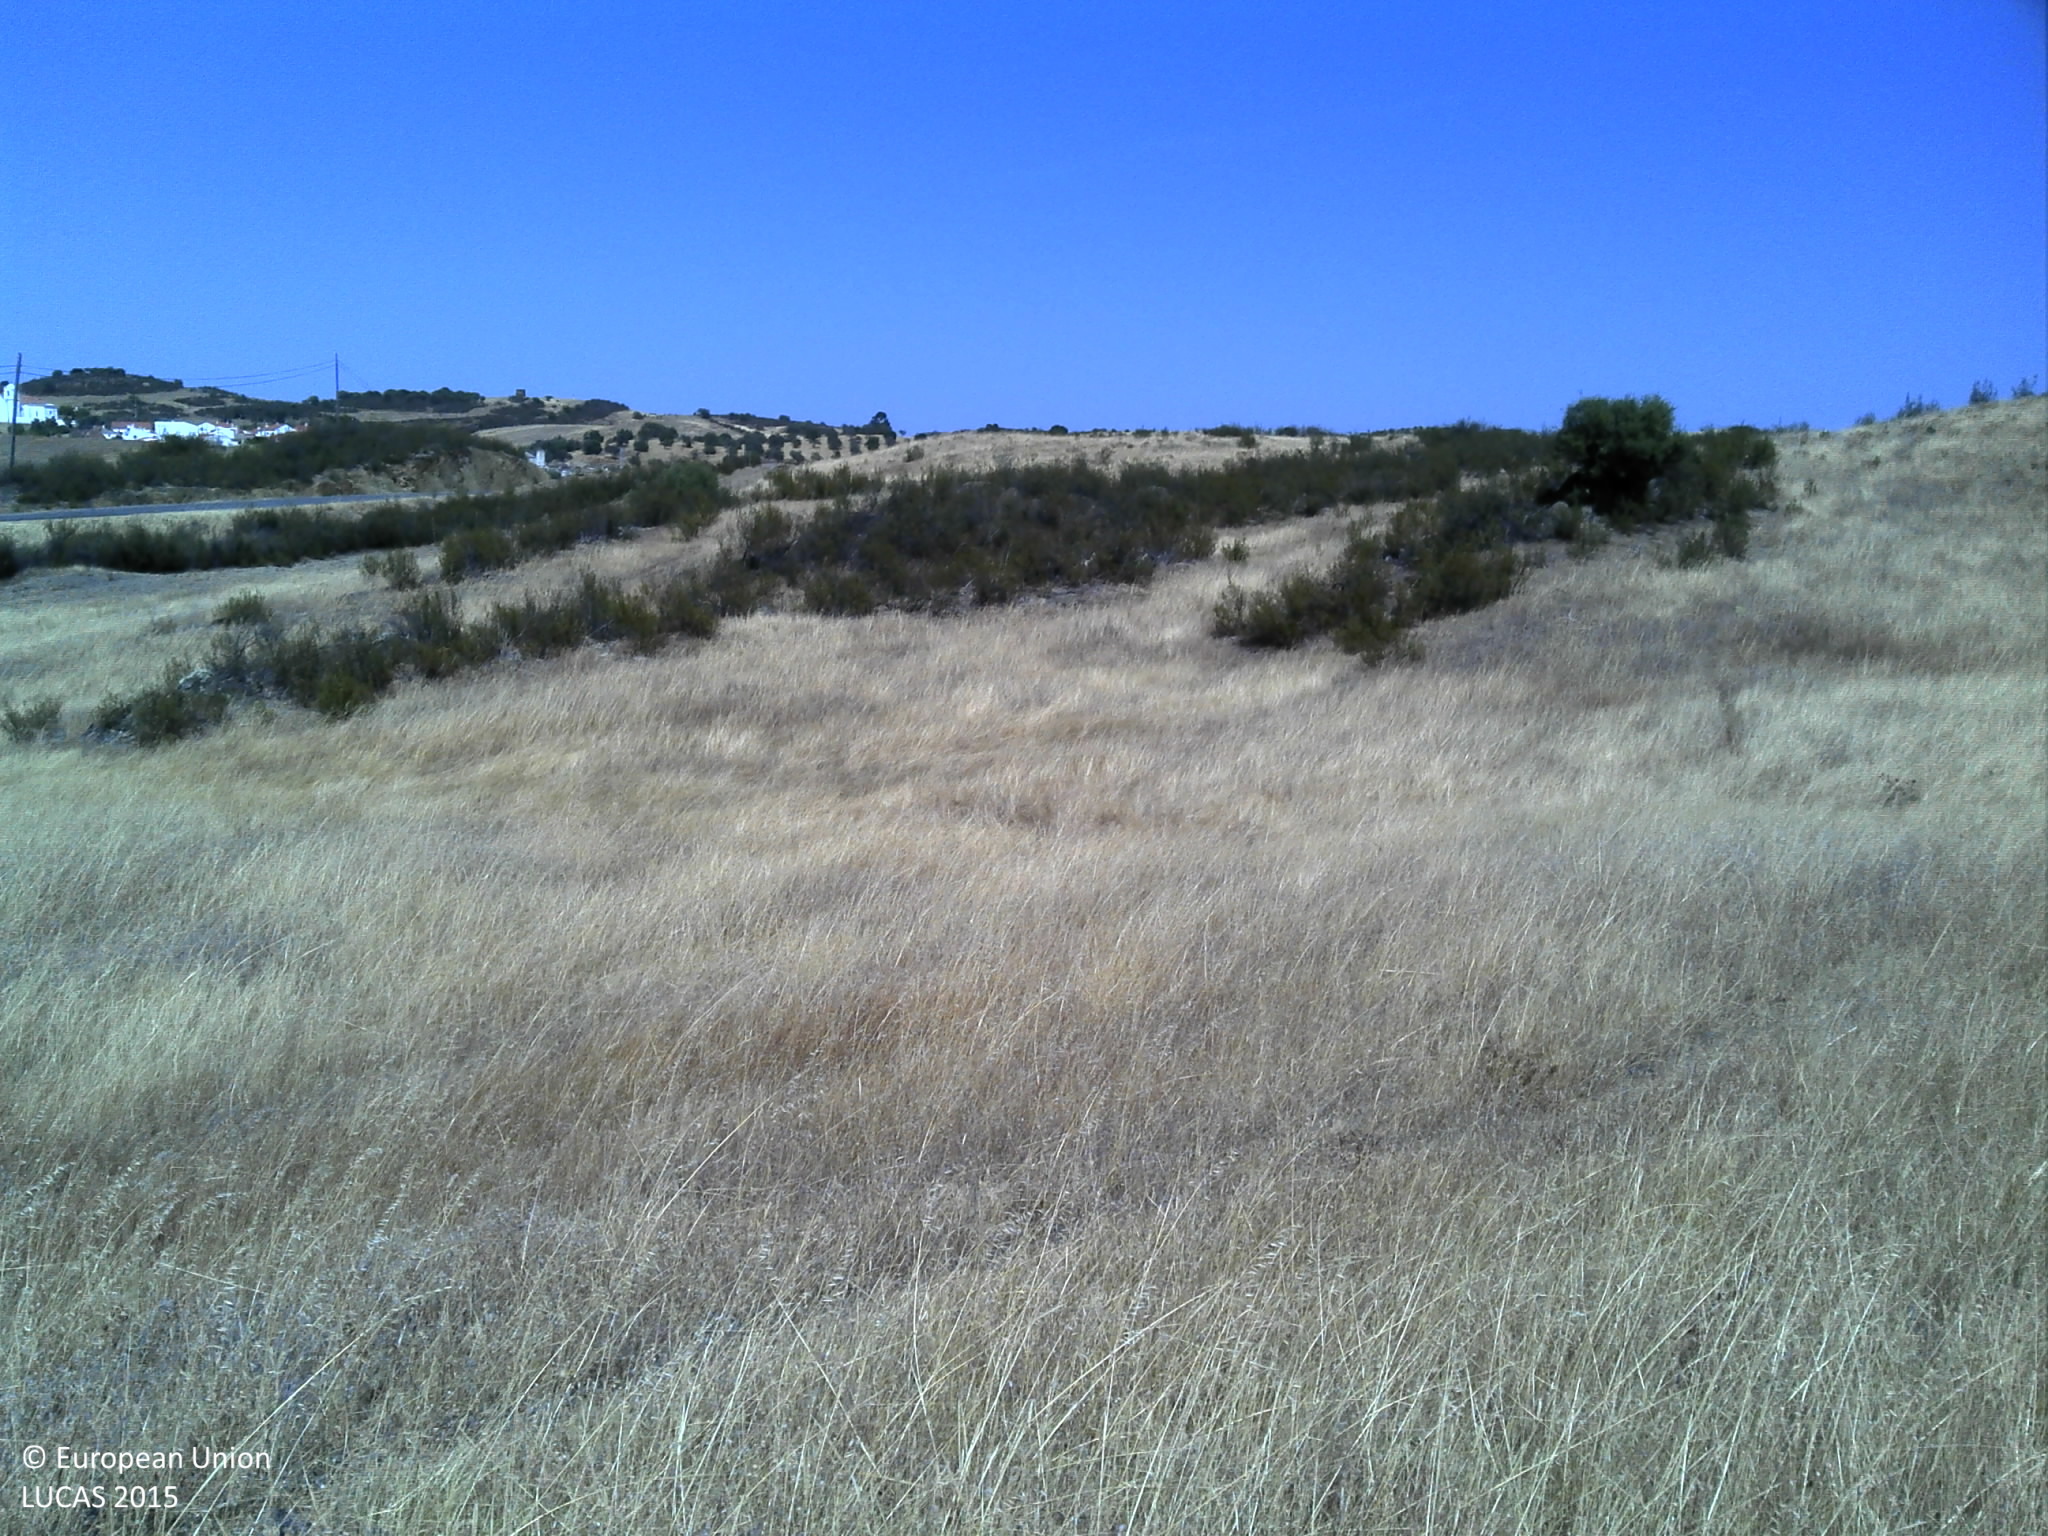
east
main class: Grassland
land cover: Grassland without tree/shrub cover
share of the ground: > 75 %
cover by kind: herbaceous plants 90 %, unconsolidated bare surface 10 %
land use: Agriculture (excluding fallow land and kitchen gardens)
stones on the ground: < 10 %
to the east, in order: Grassland without tree/shrub cover; Rock outcrops; Grassland without tree/shrub cover; Rock outcrops; Grassland without tree/shrub cover
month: July
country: PT
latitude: 37.5567
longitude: -7.7777
